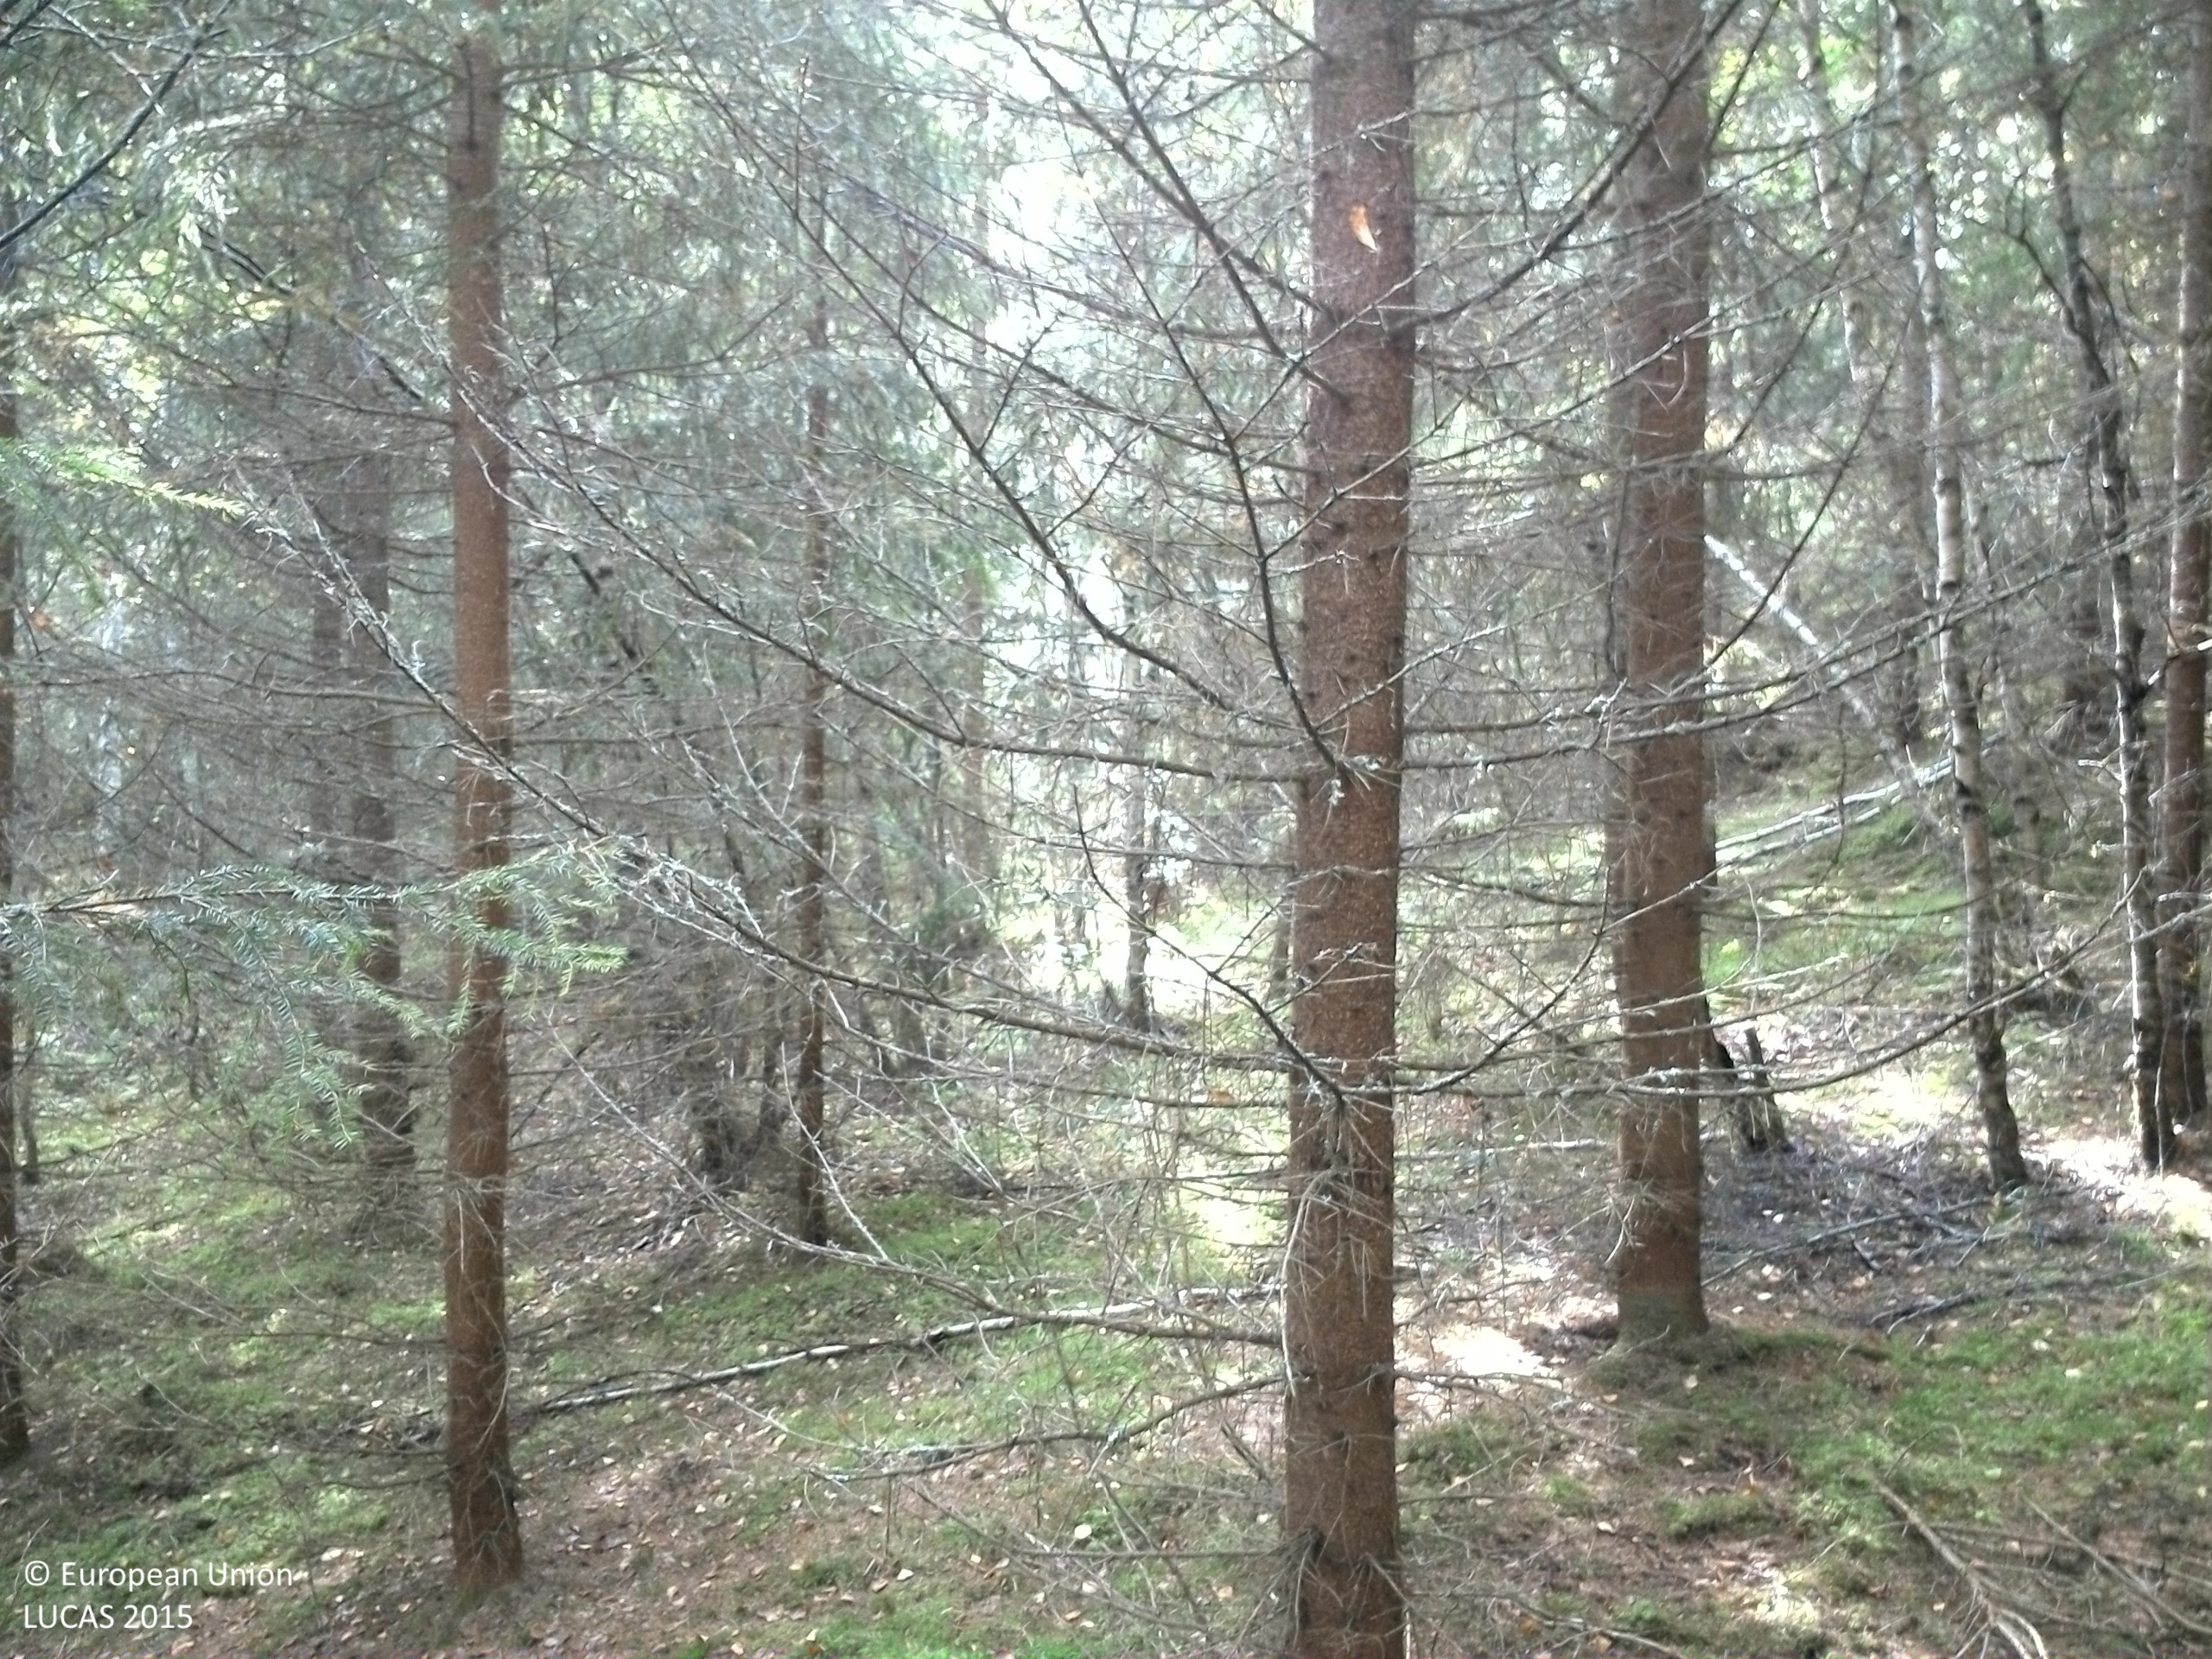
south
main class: Woodland
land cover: Spruce dominated coniferous woodland
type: boreal forest
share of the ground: 50 - 75 %
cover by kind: coniferous forest trees 60 %, lichens and mosses 20 %, broadleaved forest trees 10 %, shrubs 5 %, herbaceous plants 5 %
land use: Forestry
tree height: > 5 m
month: September
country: SE
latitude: 59.9566
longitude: 13.5185
